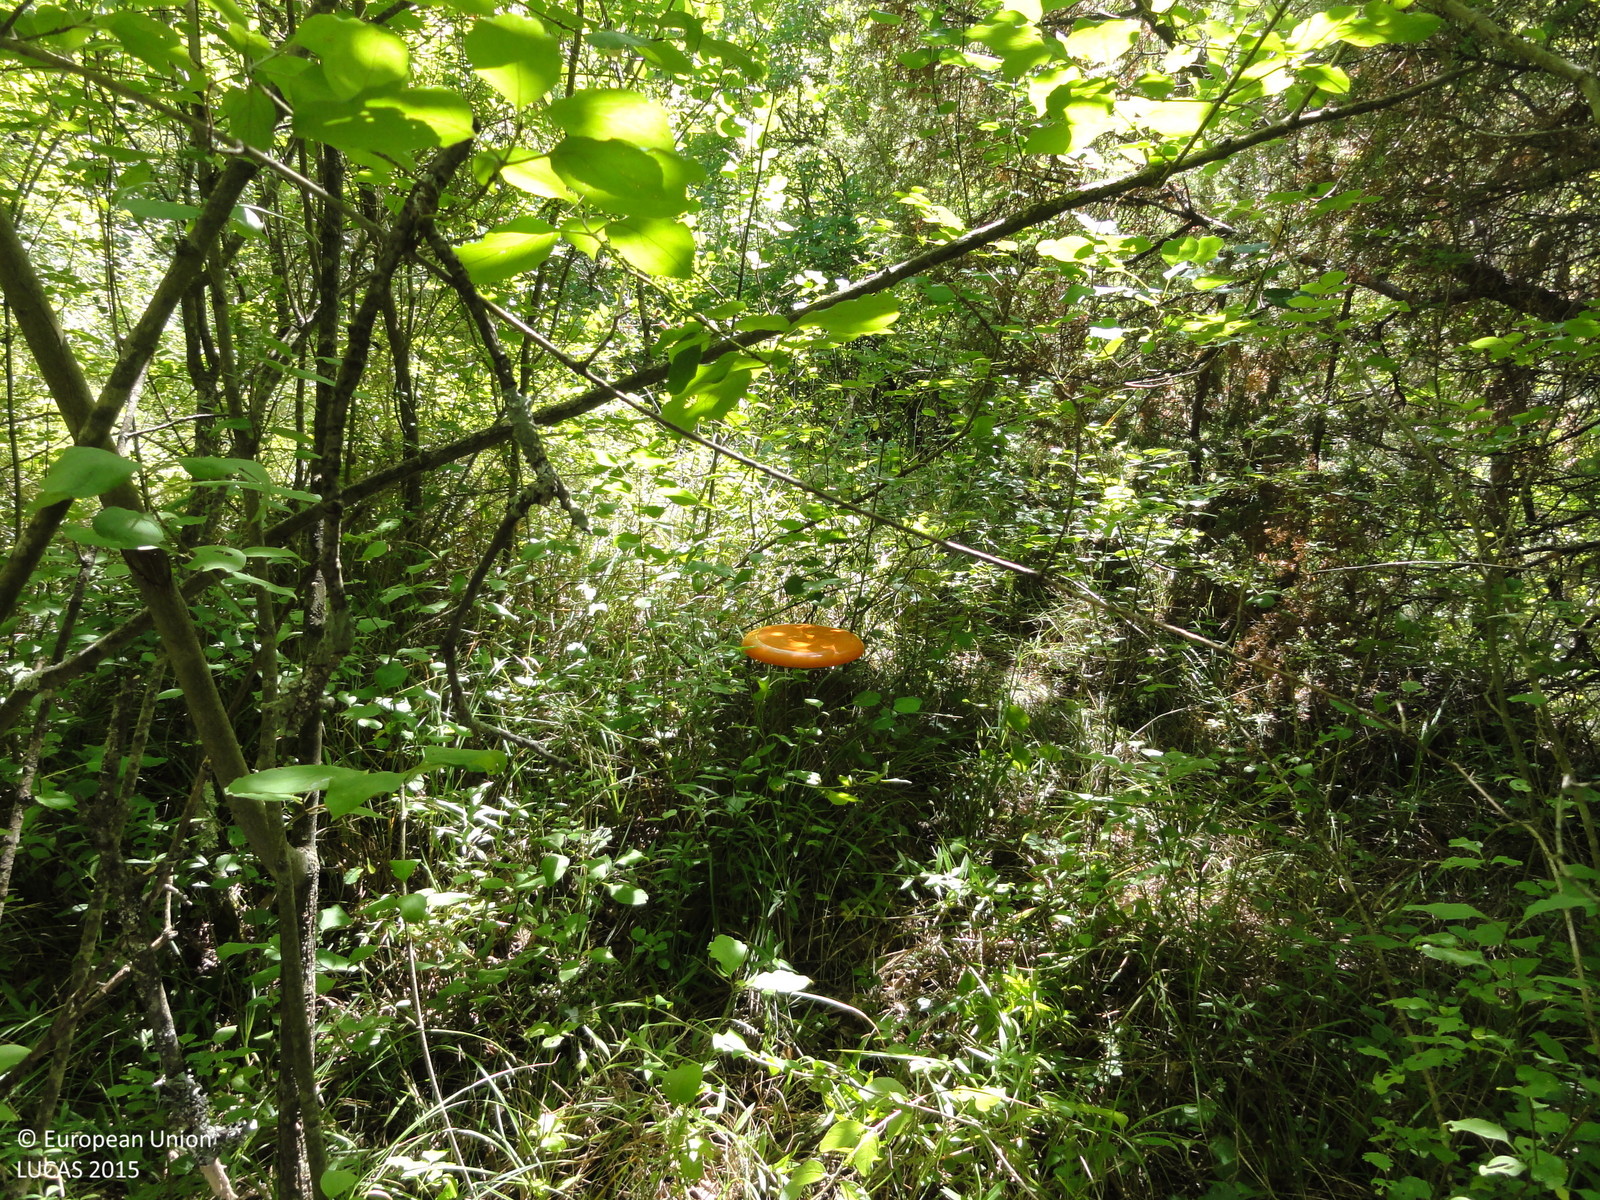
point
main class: Woodland
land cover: Broadleaved woodland
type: thermophilous deciduous forest
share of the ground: > 75 %
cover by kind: broadleaved forest trees 80 %, shrubs 20 %
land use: Semi-natural and natural areas not in use
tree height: > 5 m
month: July
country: SI
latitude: 45.4948
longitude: 13.6679
